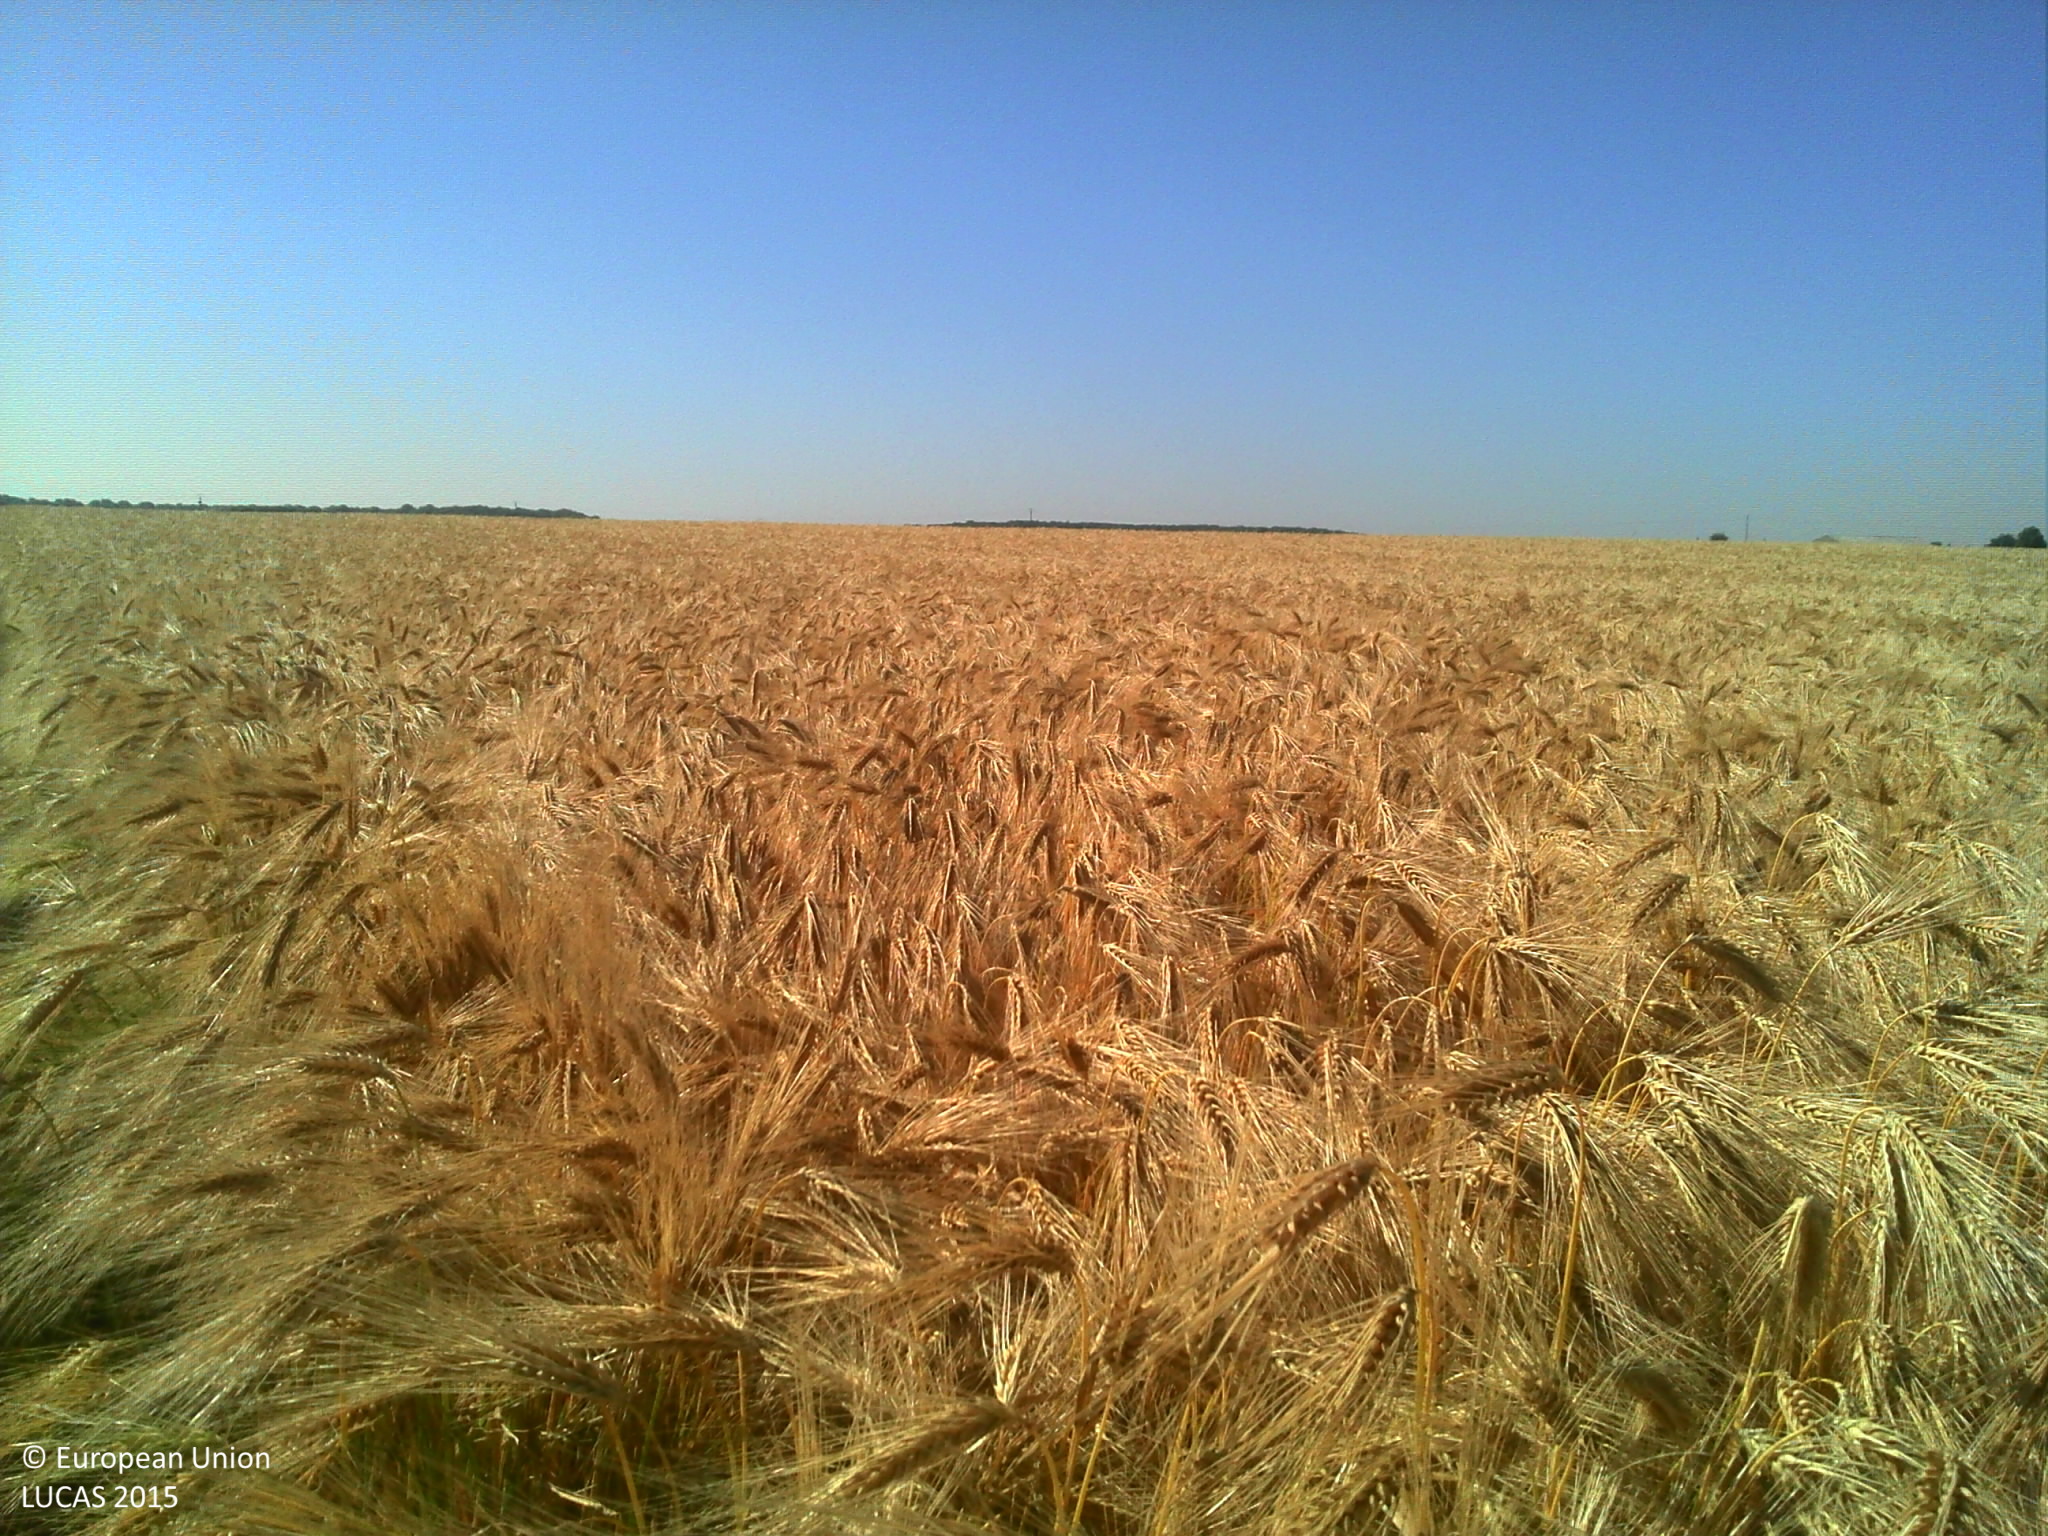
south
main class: Cropland
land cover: Barley
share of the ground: > 75 %
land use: Agriculture (excluding fallow land and kitchen gardens)
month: June
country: FR
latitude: 49.7777
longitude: 2.2792
